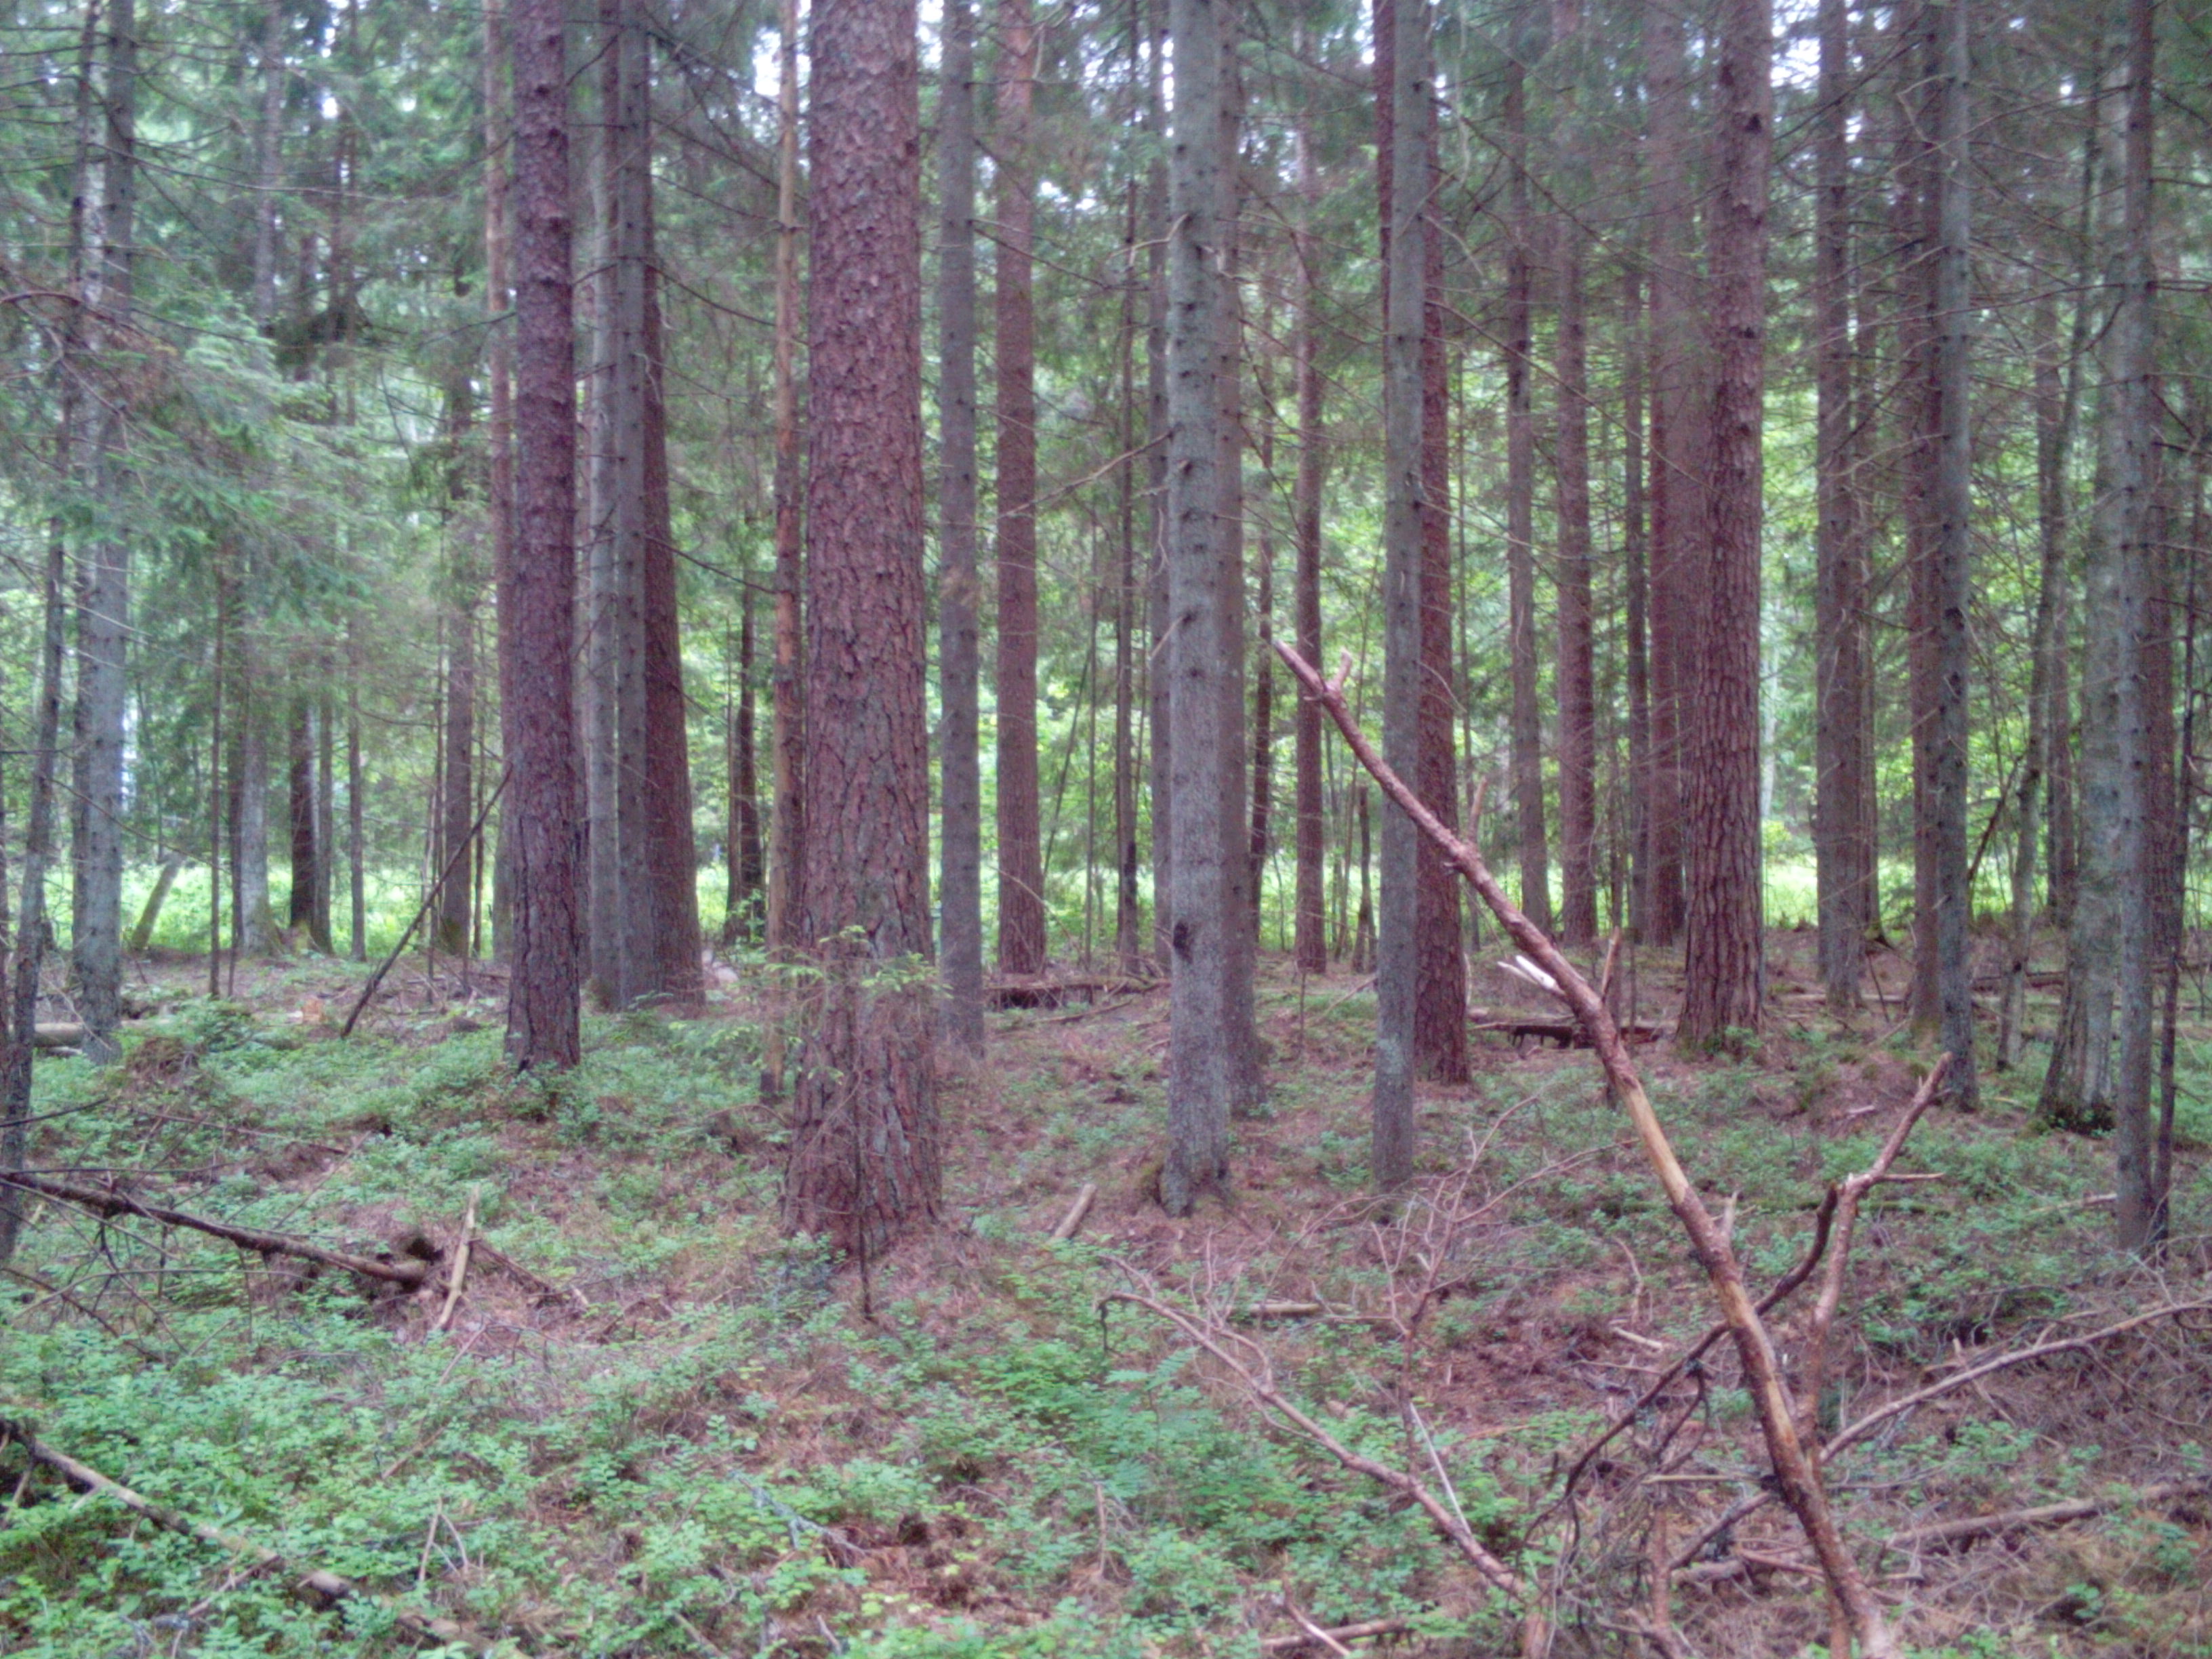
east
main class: Woodland
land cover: Other coniferous woodland
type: hemiboreal forest and nemoral coniferous forest and mixed broadleaved-coniferous forest
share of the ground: > 75 %
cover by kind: coniferous forest trees 85 %, herbaceous plants 10 %, lichens and mosses 5 %
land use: Forestry
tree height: > 5 m
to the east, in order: Other coniferous woodland; Spruce dominated coniferous woodland; Ditches and canals; Shruby margins; Paved roads, cycling and walking lanes; Shruby margins; Ditches and canals; Spruce dominated coniferous woodland; Spruce dominated mixed woodland; Ponds and wetlands; Spruce dominated mixed woodland; Grassland without tree/shrub cover
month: June
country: LV
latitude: 56.8180
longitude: 21.4592
